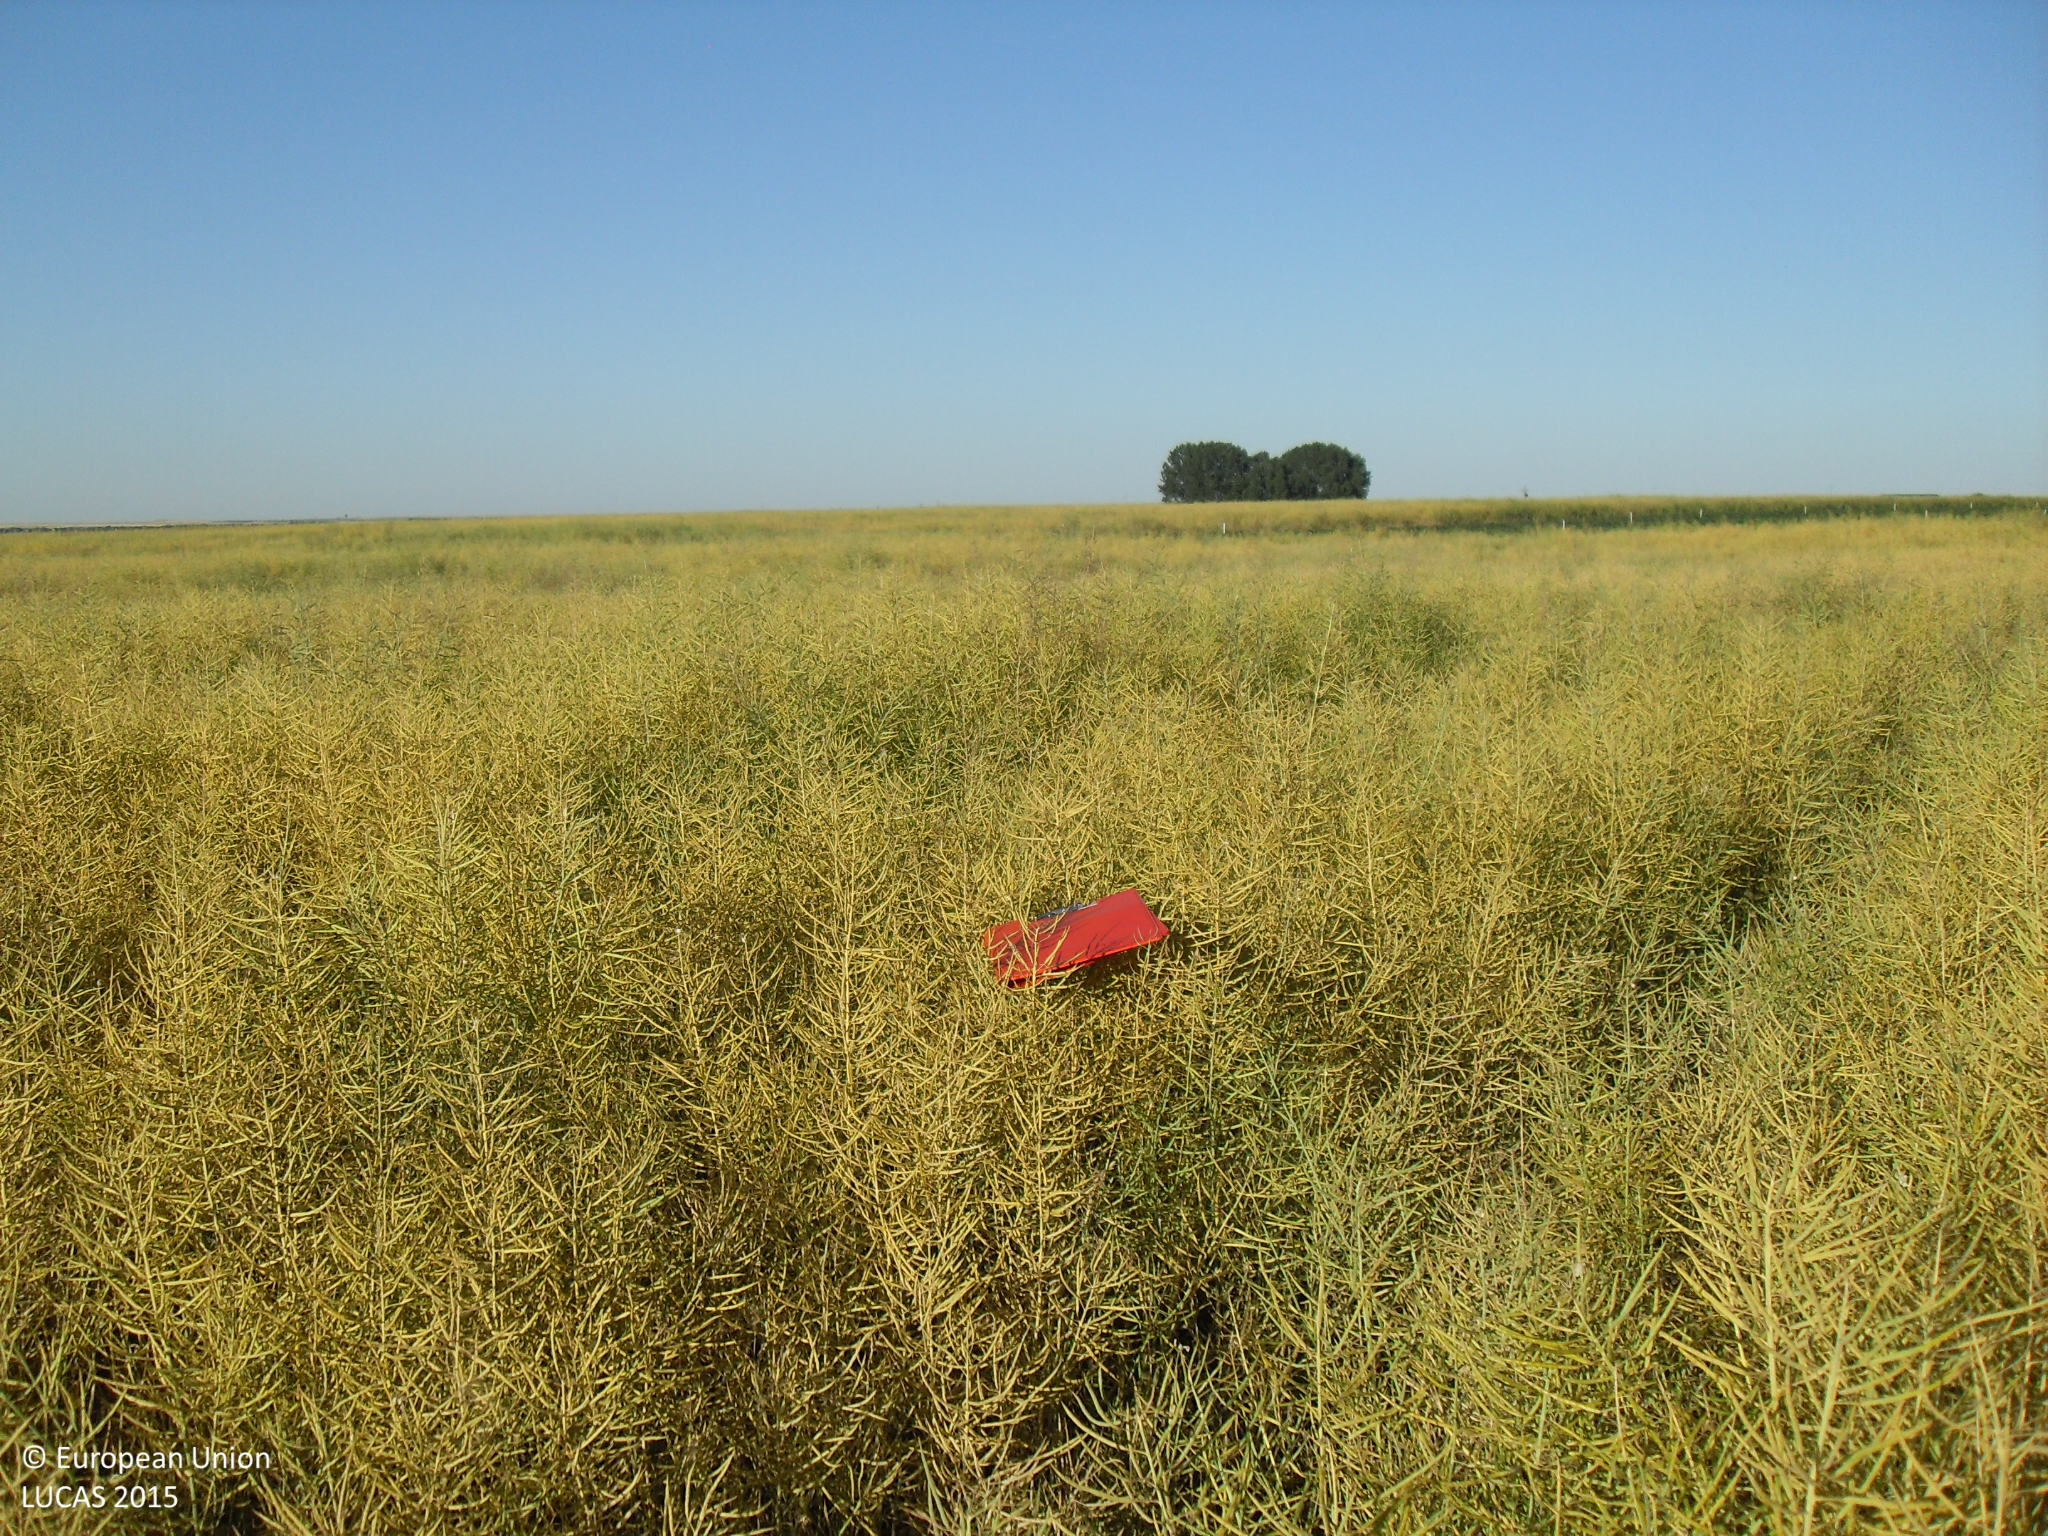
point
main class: Cropland
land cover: Rape and turnip rape
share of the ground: > 75 %
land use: Agriculture (excluding fallow land and kitchen gardens)
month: May
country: ES
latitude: 41.0872
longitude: -5.3702
